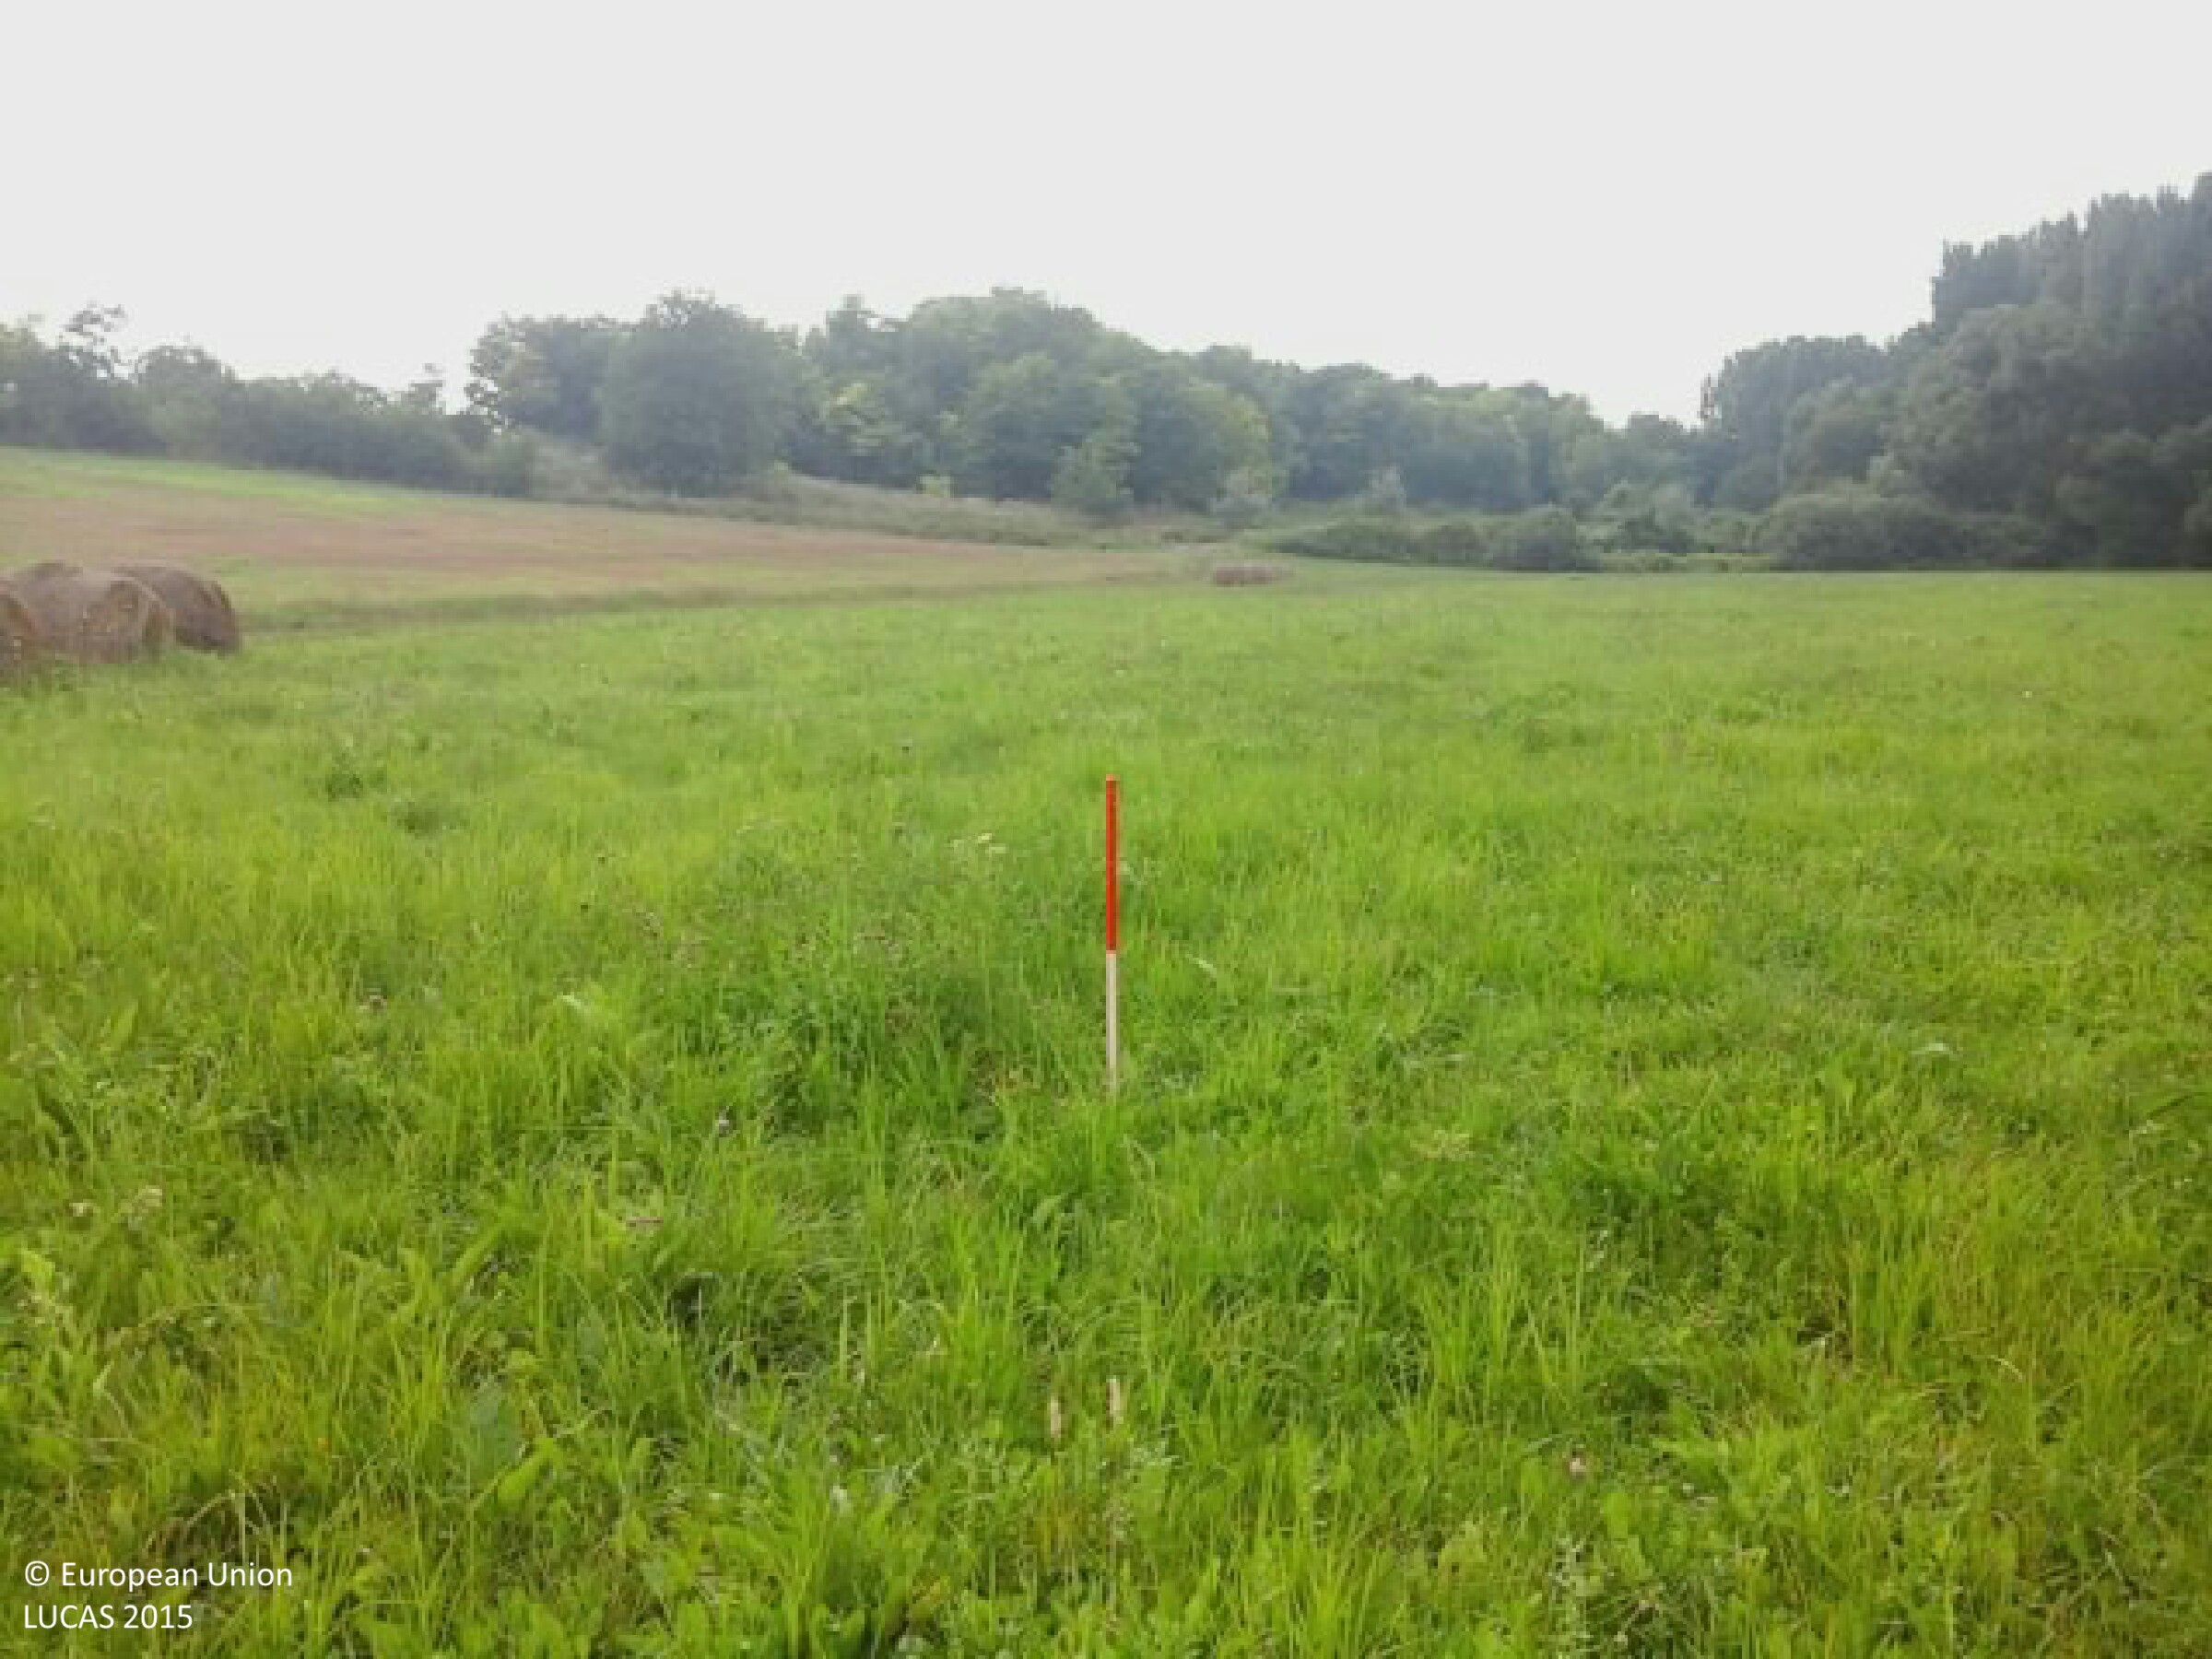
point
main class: Grassland
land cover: Grassland without tree/shrub cover
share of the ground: > 75 %
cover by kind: herbaceous plants 100 %
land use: Agriculture (excluding fallow land and kitchen gardens)
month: August
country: HU
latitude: 46.3092
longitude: 18.4103
